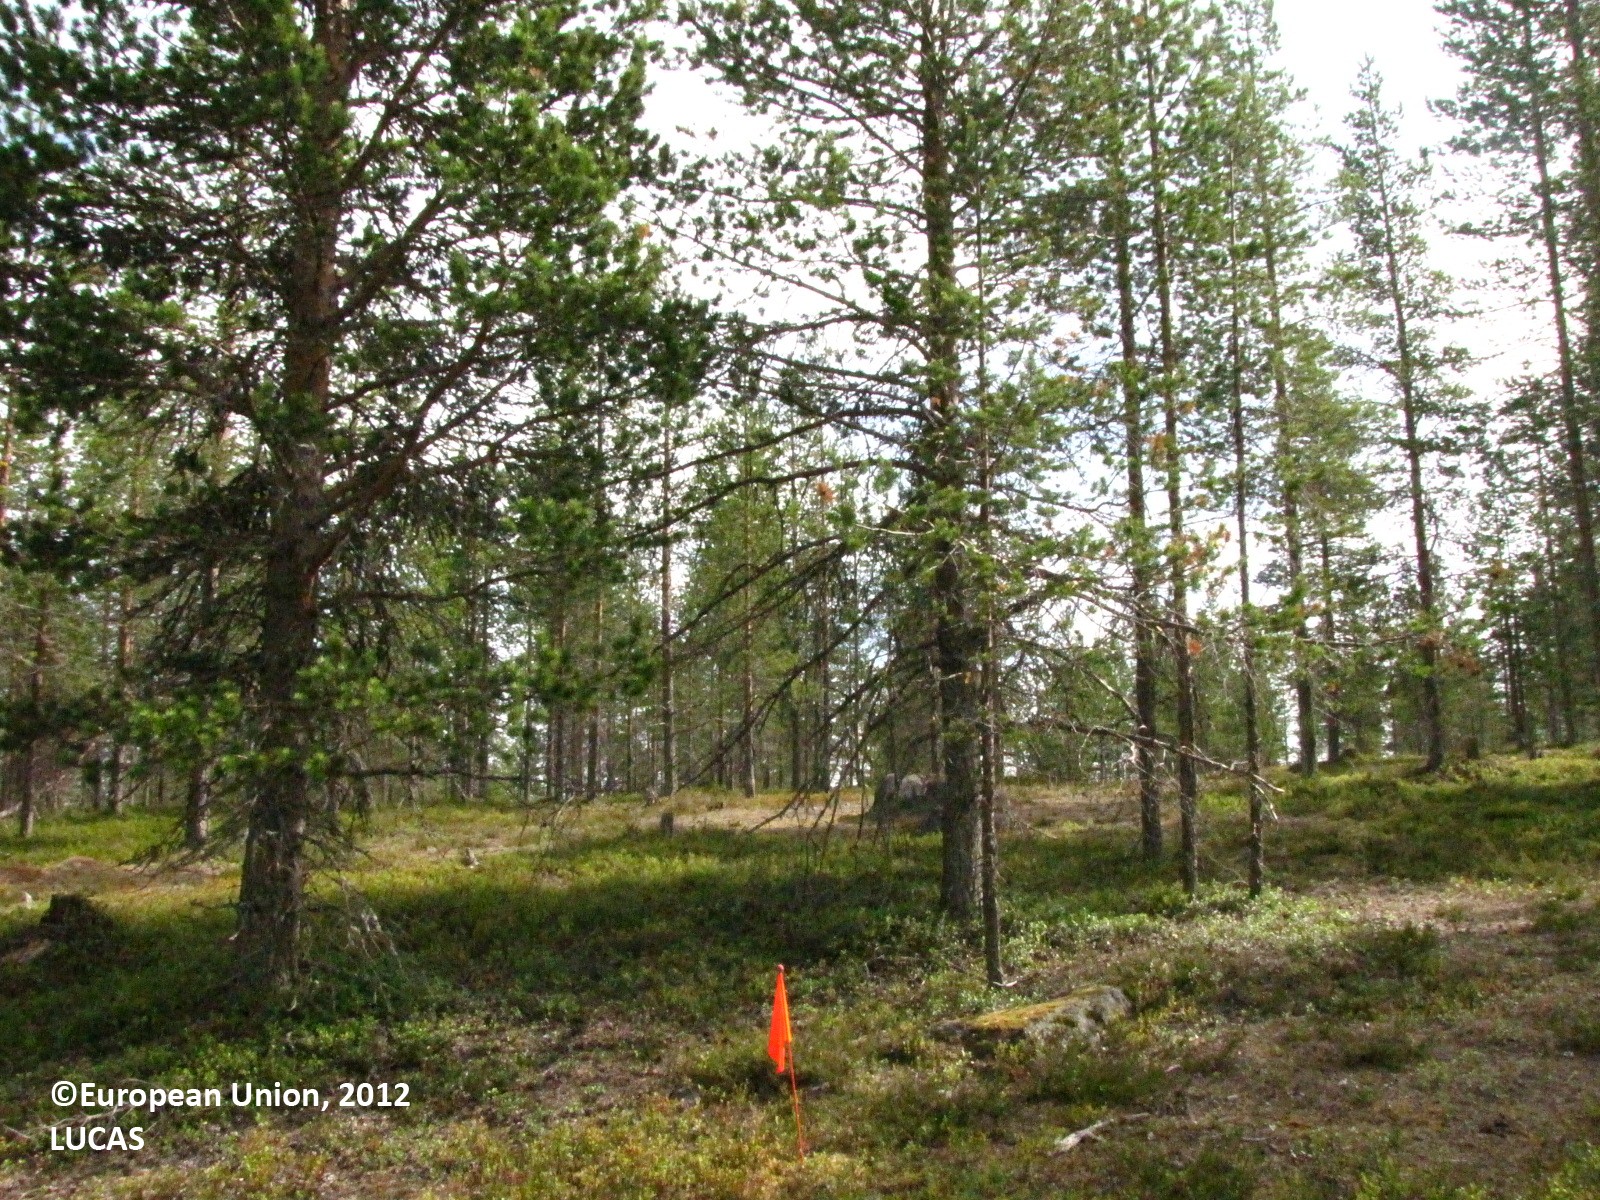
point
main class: Woodland
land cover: Pine dominated coniferous woodland
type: boreal forest
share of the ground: 50 - 75 %
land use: Forestry
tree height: > 5 m
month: July
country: FI
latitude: 66.6439
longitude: 25.1315
